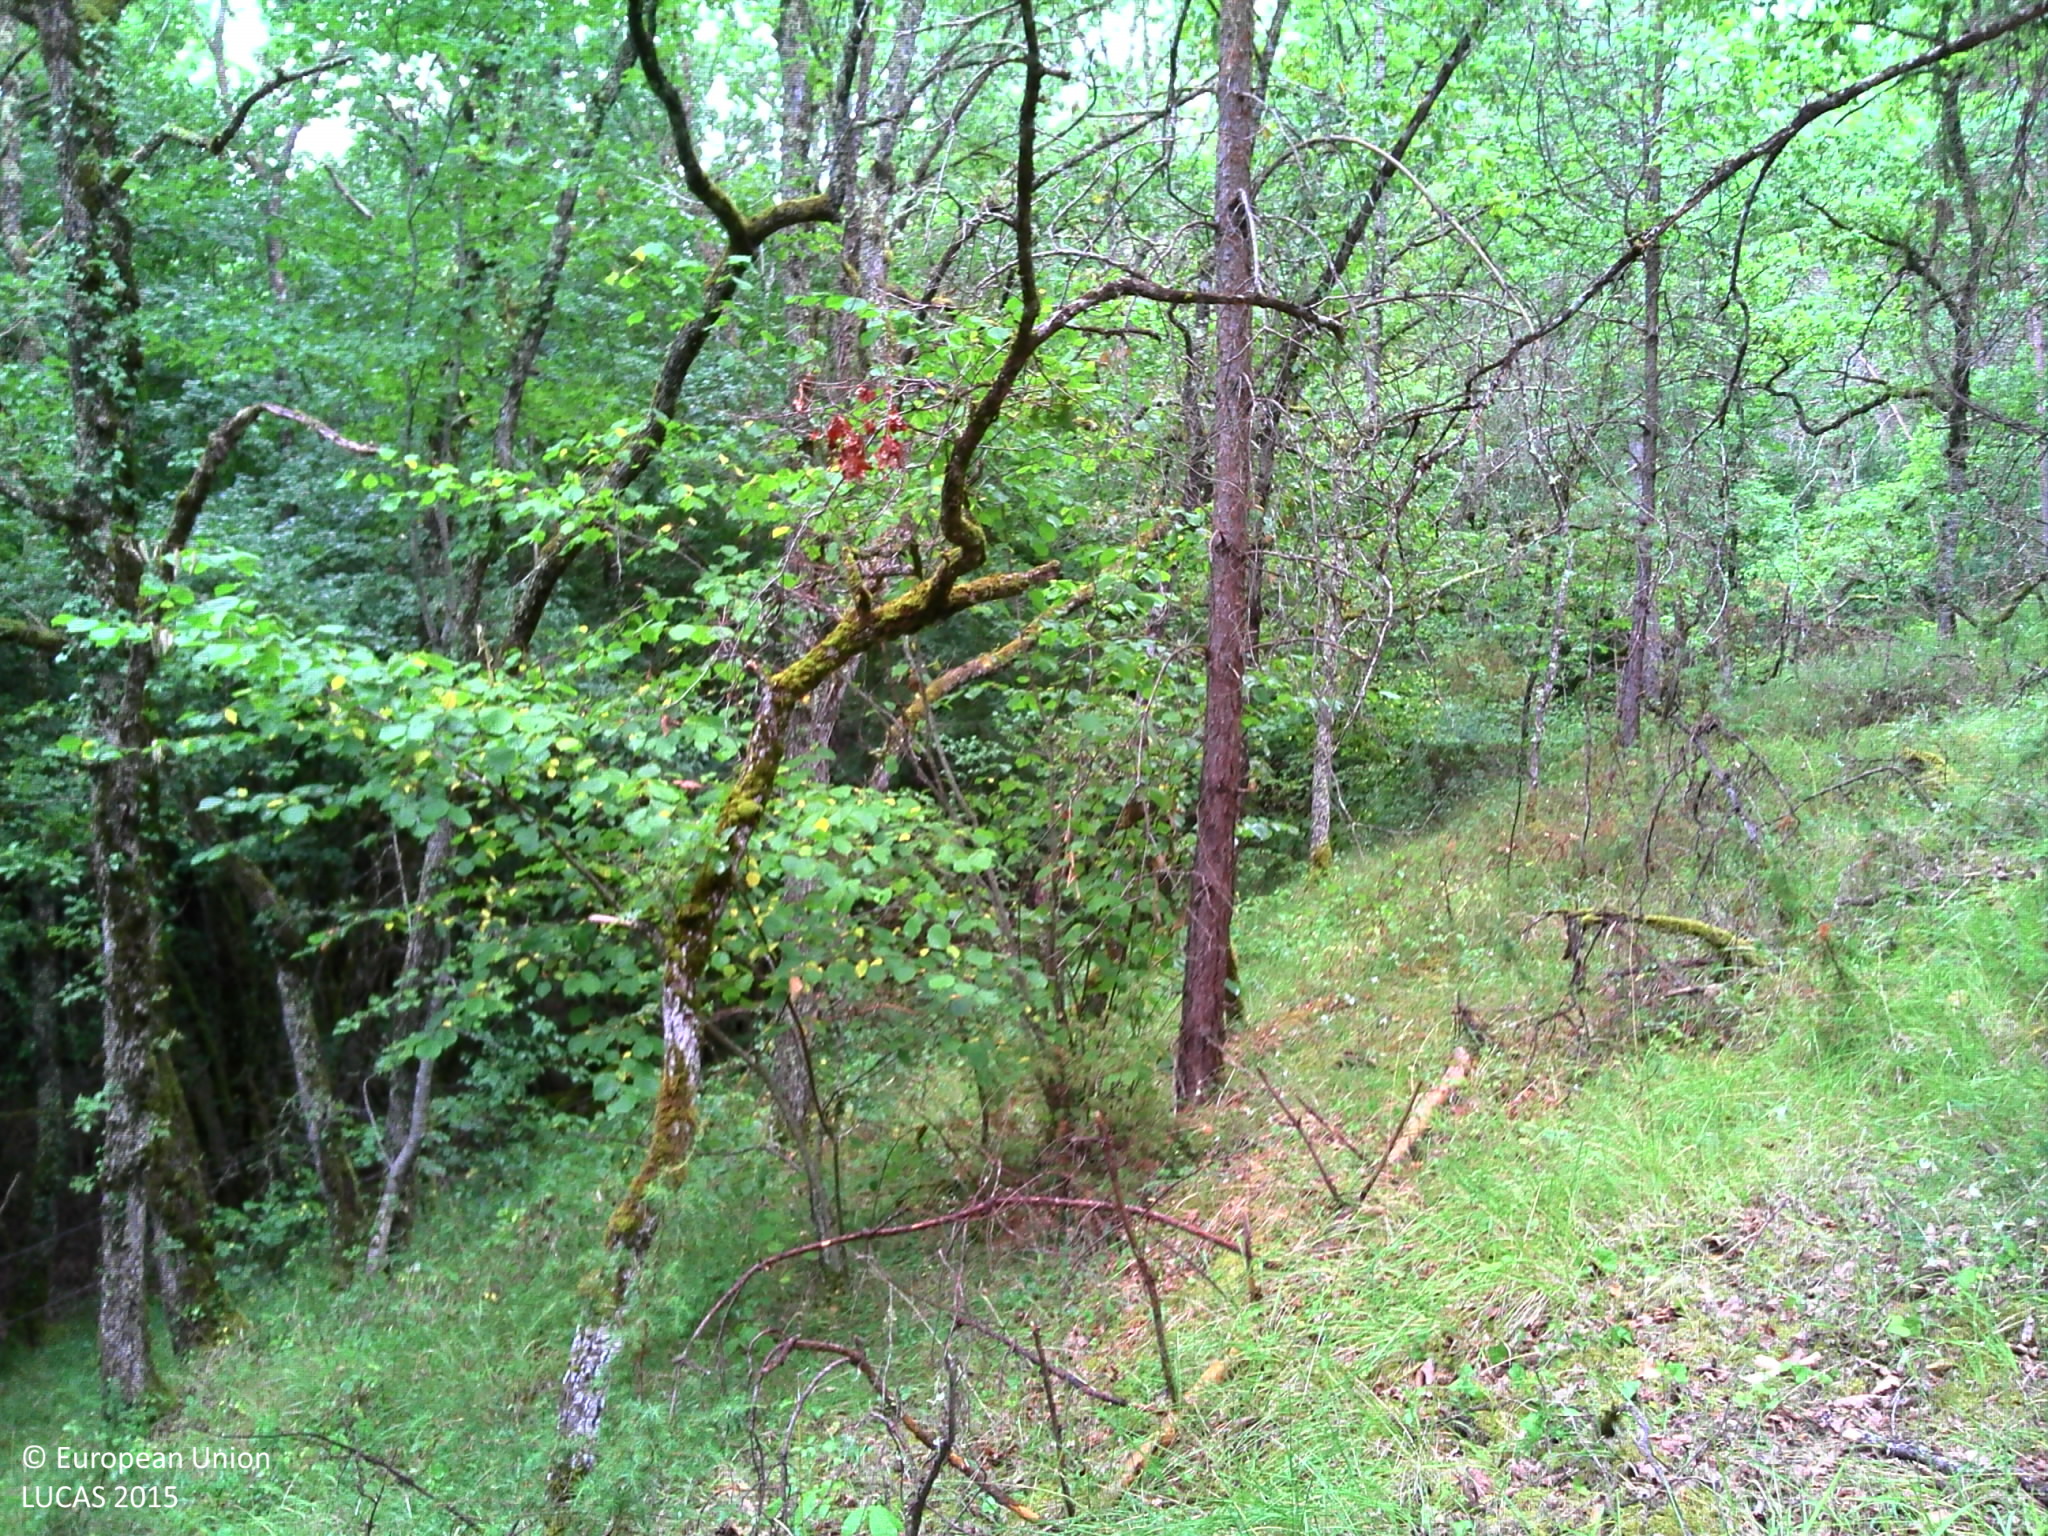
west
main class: Woodland
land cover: Pine dominated mixed woodland
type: hemiboreal forest and nemoral coniferous forest and mixed broadleaved-coniferous forest
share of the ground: > 75 %
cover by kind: broadleaved forest trees 50 %, coniferous forest trees 30 %, shrubs 10 %, herbaceous plants 10 %
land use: Forestry
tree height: > 5 m
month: July
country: FR
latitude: 44.9012
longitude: 0.7852
